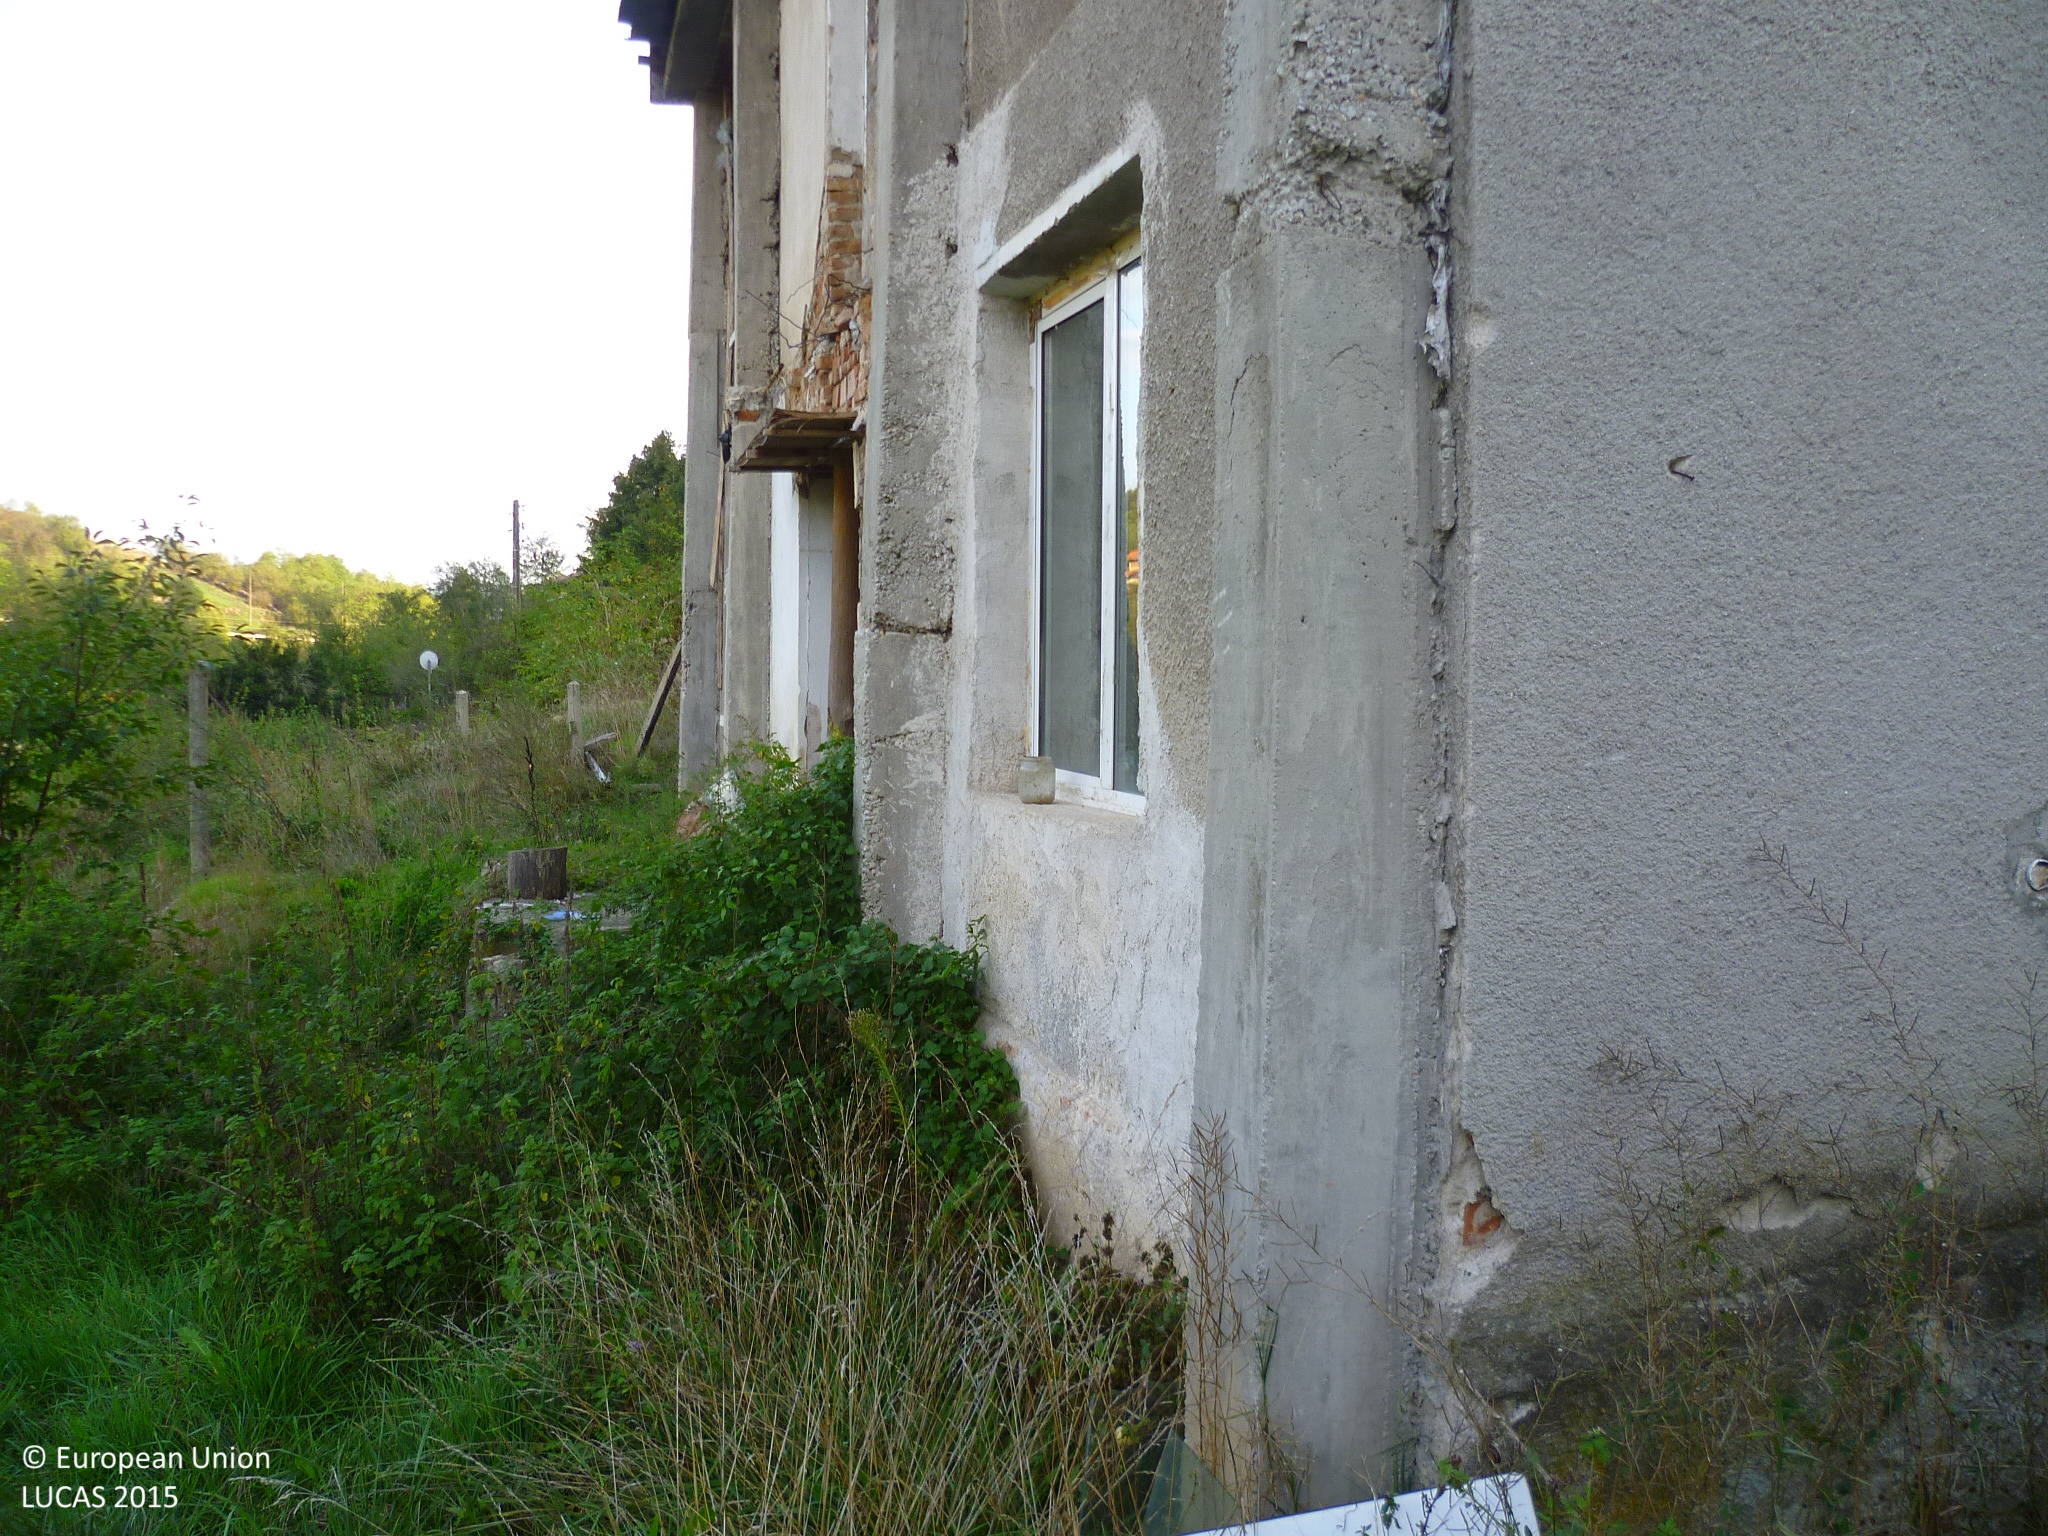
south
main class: Grassland
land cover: Grassland with sparse tree/shrub cover
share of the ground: 50 - 75 %
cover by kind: herbaceous plants 45 %, broadleaved forest trees 5 %, shrubs 5 %
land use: Residential
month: October
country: BG
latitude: 42.9147
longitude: 22.8057
